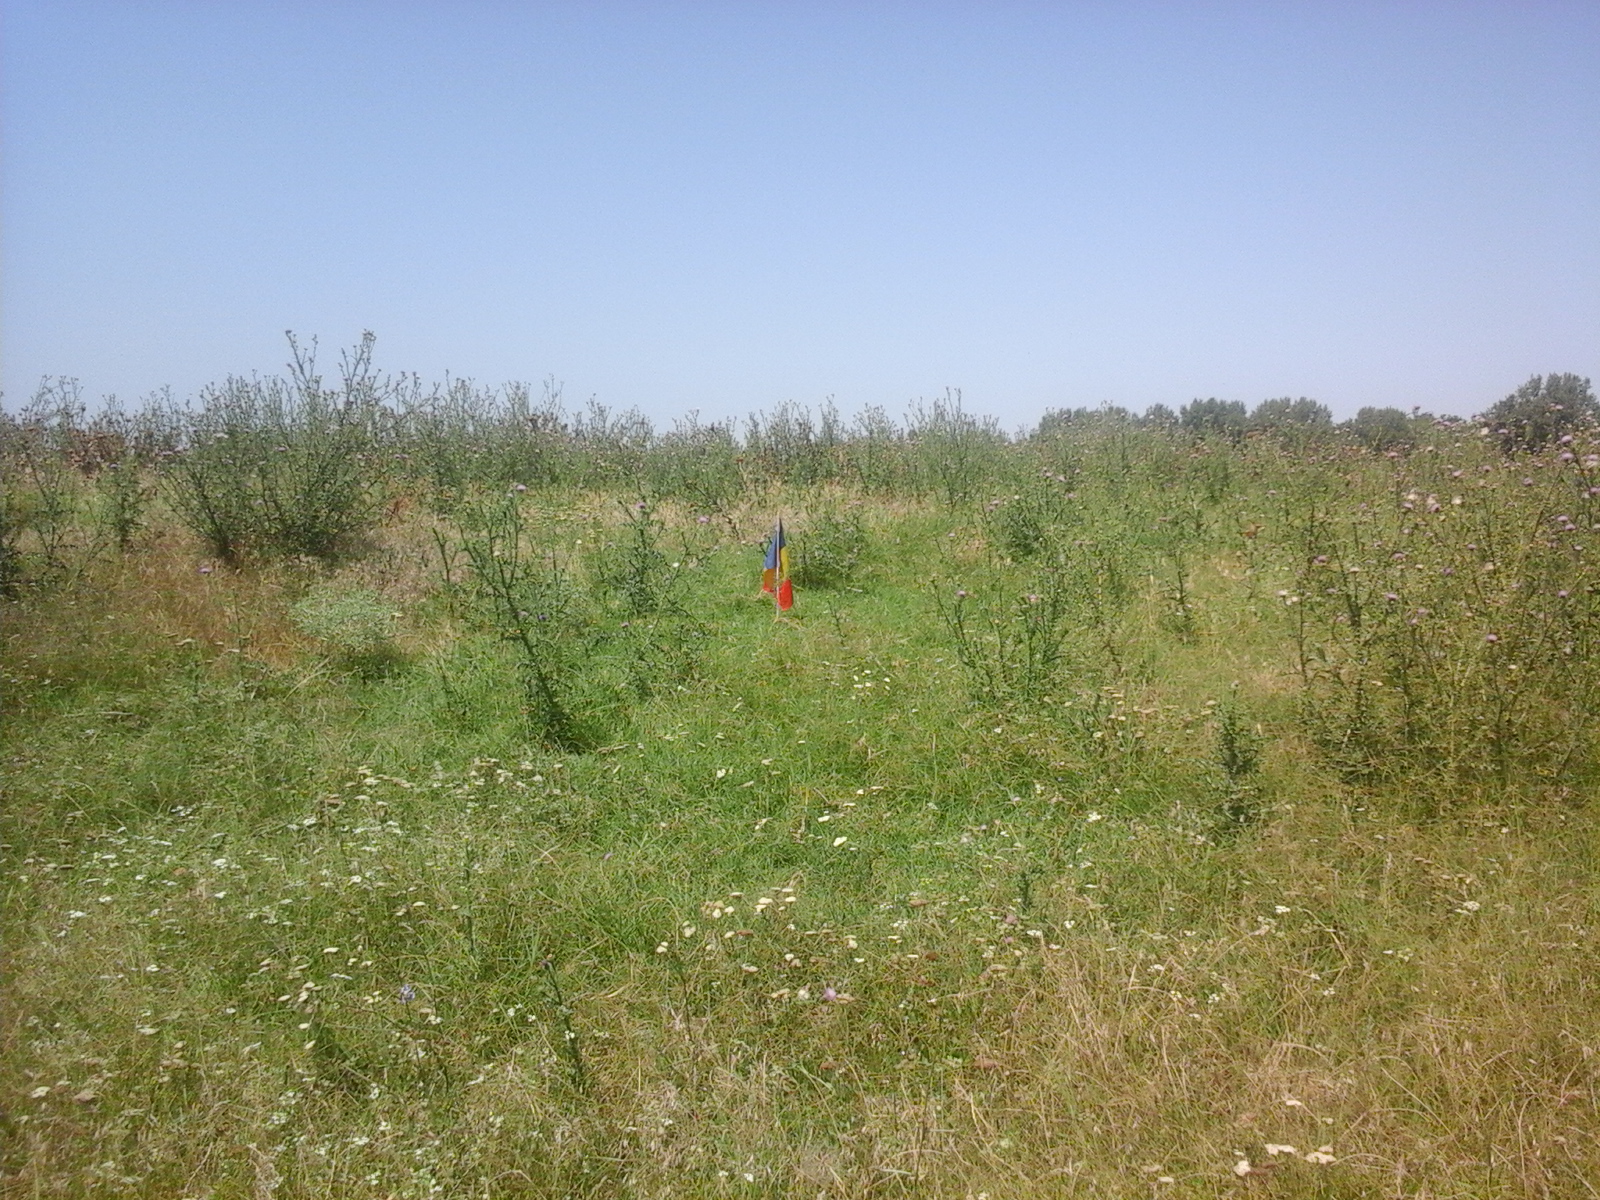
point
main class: Grassland
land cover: Spontaneously vegetated surfaces
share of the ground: > 75 %
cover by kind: herbaceous plants 100 %
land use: Fallow land
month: July
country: RO
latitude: 44.5507
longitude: 27.2431
